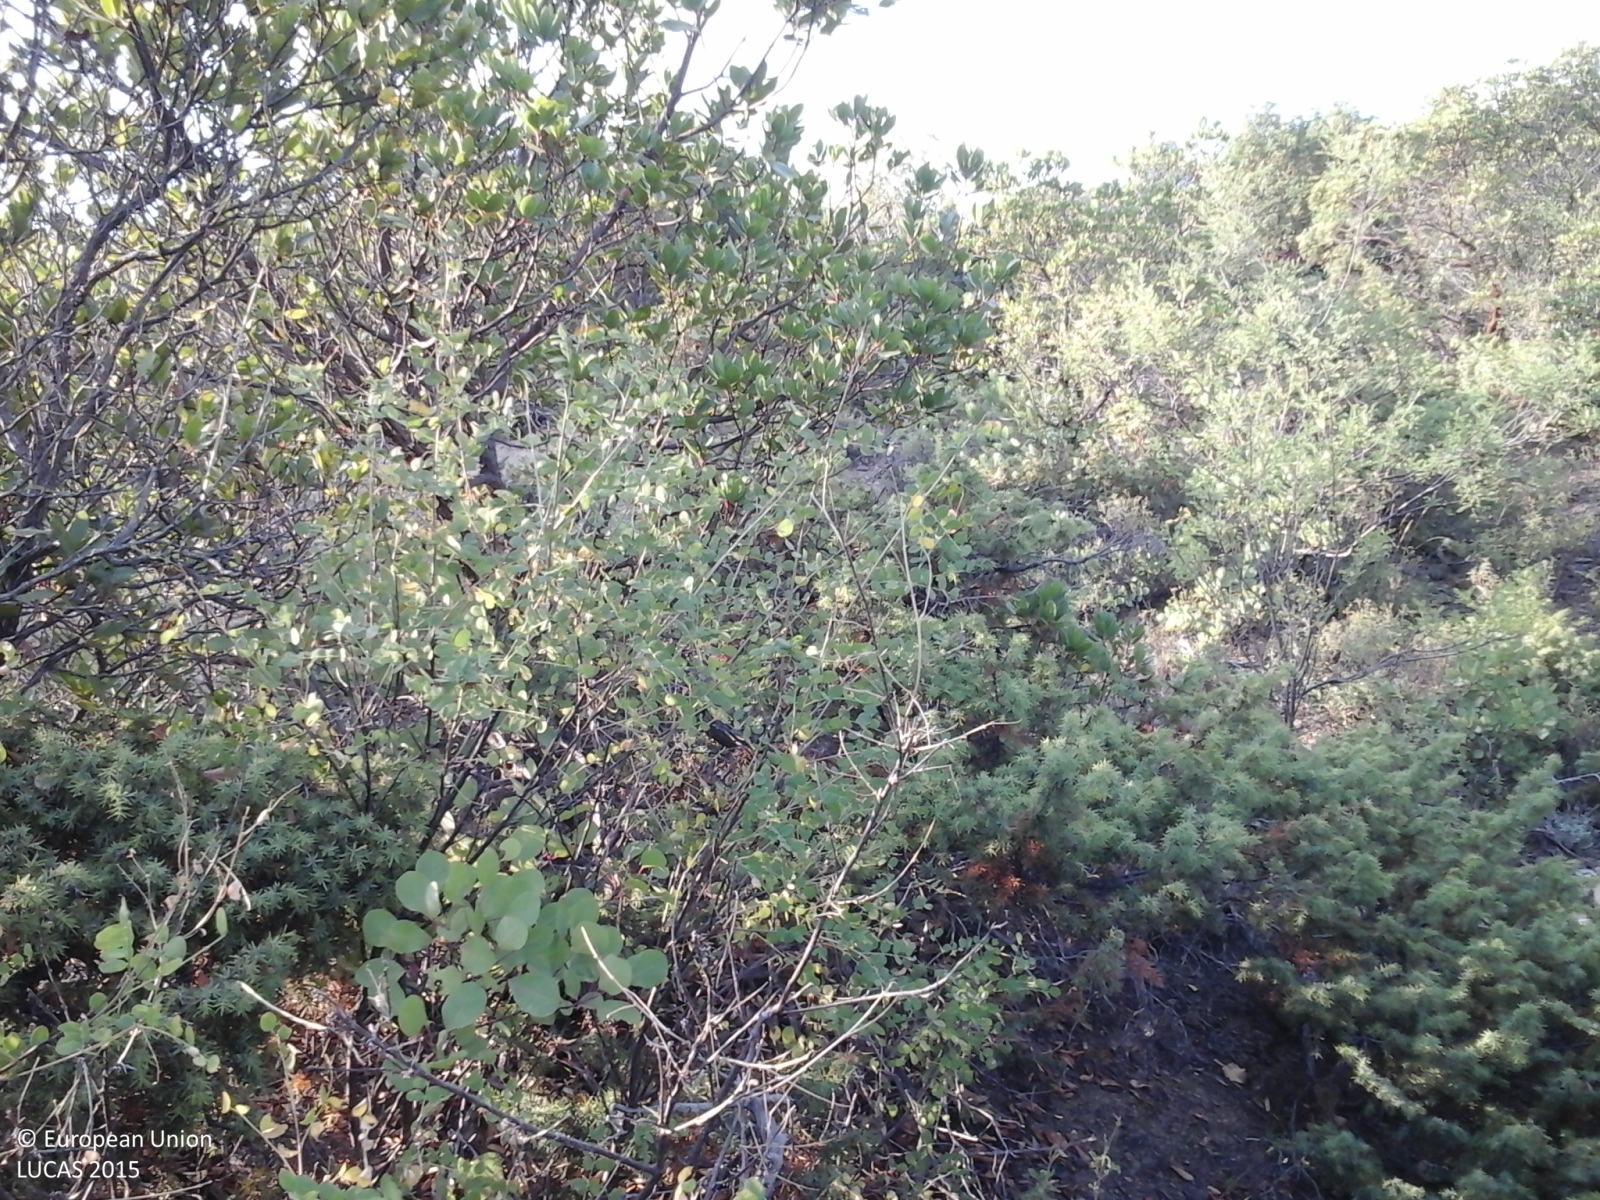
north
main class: Woodland
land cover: Broadleaved woodland
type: broadleaved evergreen forest
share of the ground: > 75 %
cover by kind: broadleaved forest trees 85 %, unconsolidated bare surface 10 %, shrubs 5 %
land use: Semi-natural and natural areas not in use
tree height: > 5 m
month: July
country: GR
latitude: 40.0803
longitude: 20.7121
